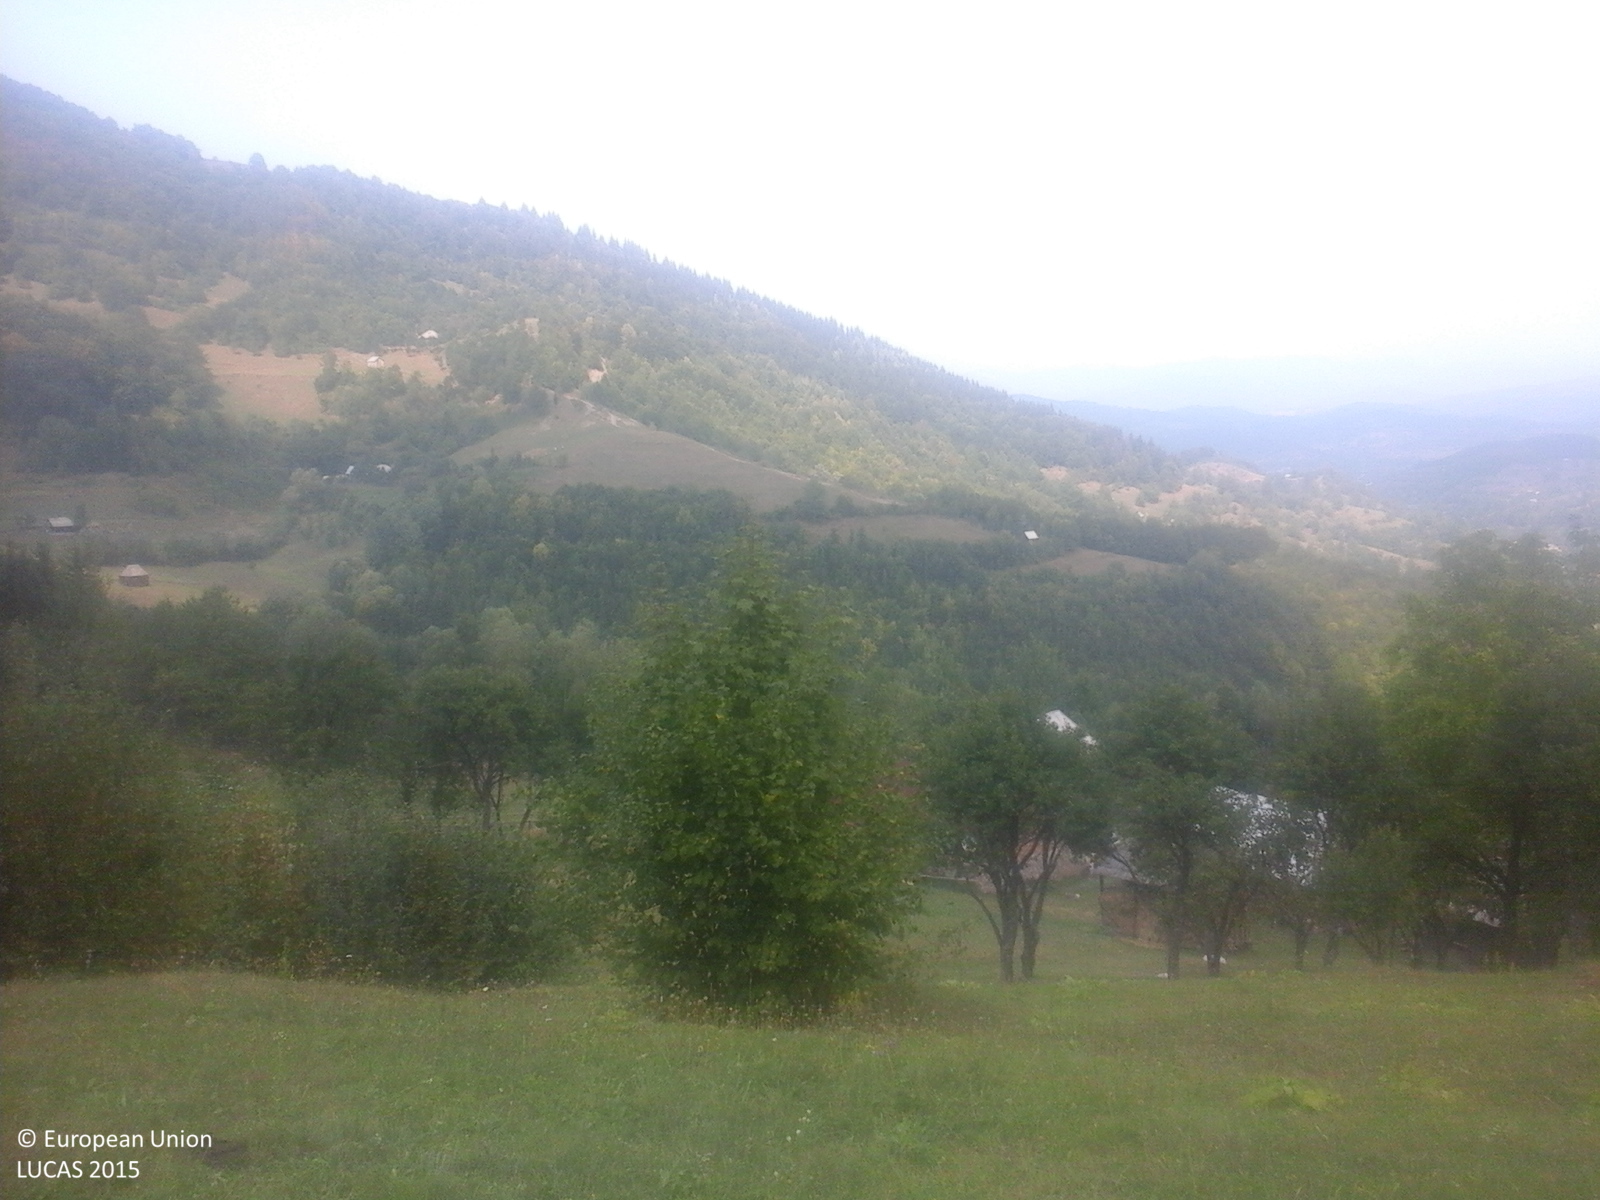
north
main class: Grassland
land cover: Grassland without tree/shrub cover
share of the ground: > 75 %
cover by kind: herbaceous plants 100 %
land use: Agriculture (excluding fallow land and kitchen gardens)
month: September
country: RO
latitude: 47.6267
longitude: 24.3429
